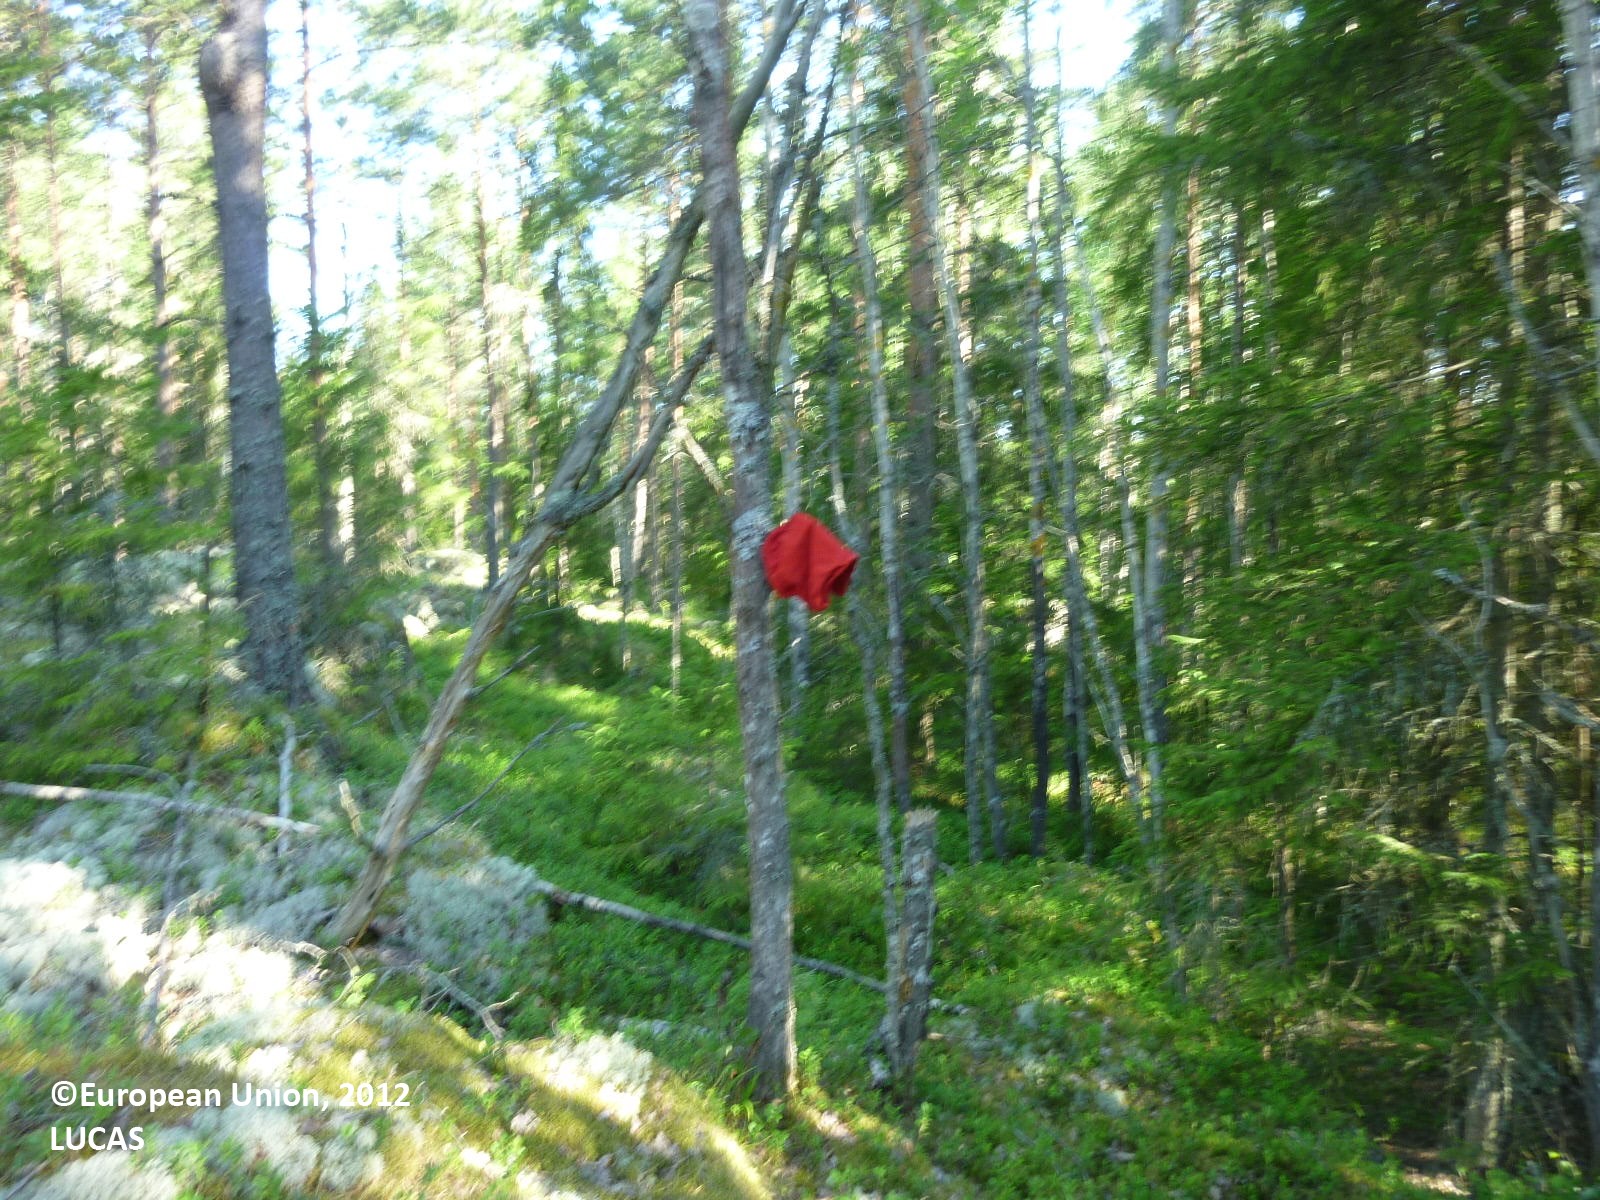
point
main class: Woodland
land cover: Pine dominated mixed woodland
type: boreal forest
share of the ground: 25 - 50 %
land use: Forestry
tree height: > 5 m
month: July
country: FI
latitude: 61.1680
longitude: 22.5773
